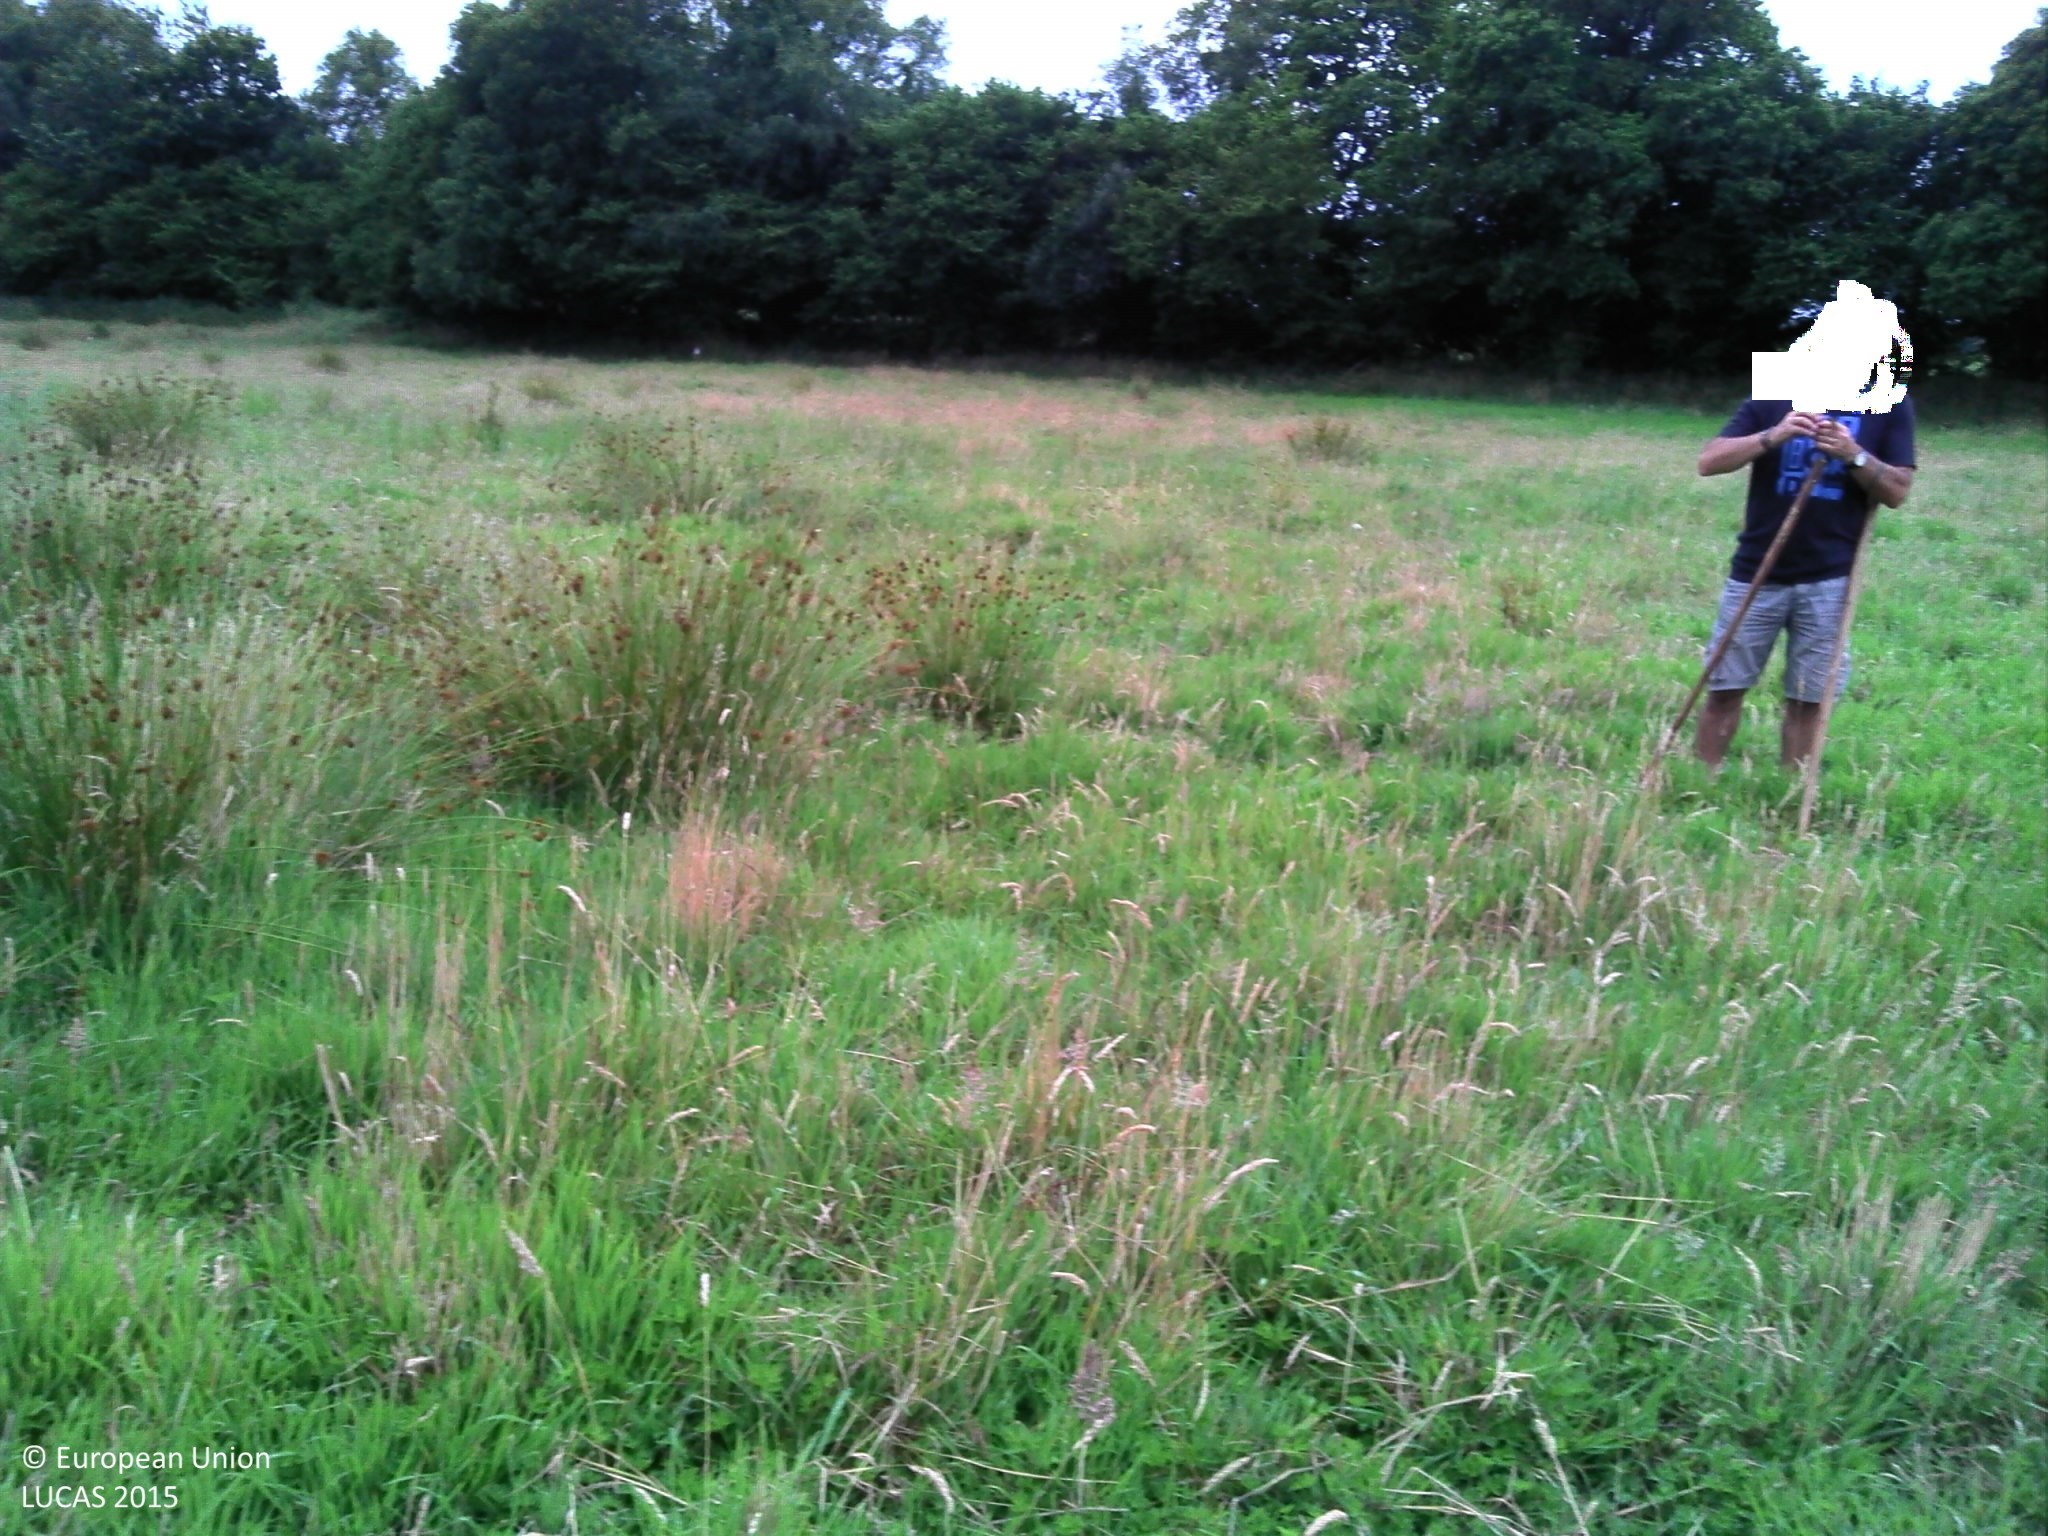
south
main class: Grassland
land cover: Grassland without tree/shrub cover
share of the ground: > 75 %
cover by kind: herbaceous plants 100 %
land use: Agriculture (excluding fallow land and kitchen gardens)
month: July
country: FR
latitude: 48.1340
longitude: -3.6656
